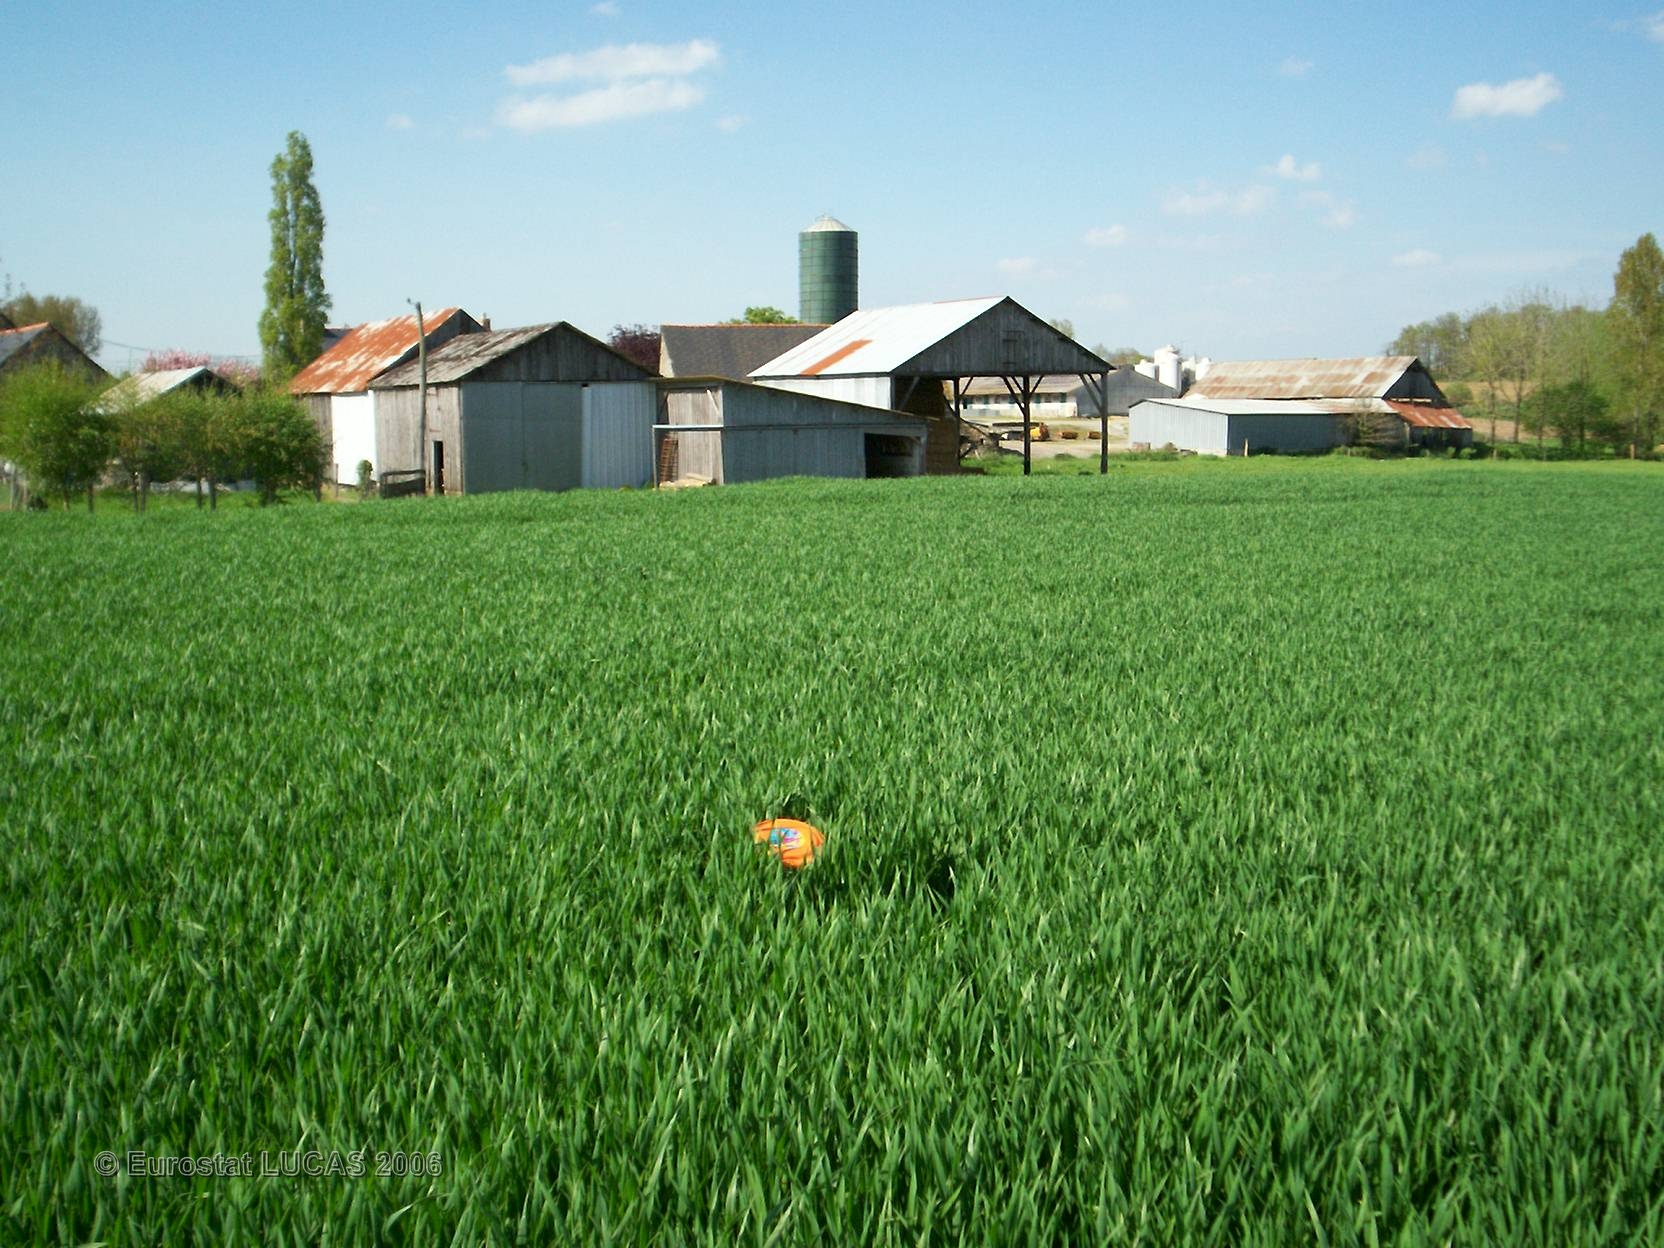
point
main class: Cropland
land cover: Common wheat
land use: Agriculture (excluding fallow land and kitchen gardens)
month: May
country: FR
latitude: 48.1457
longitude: -1.1565
